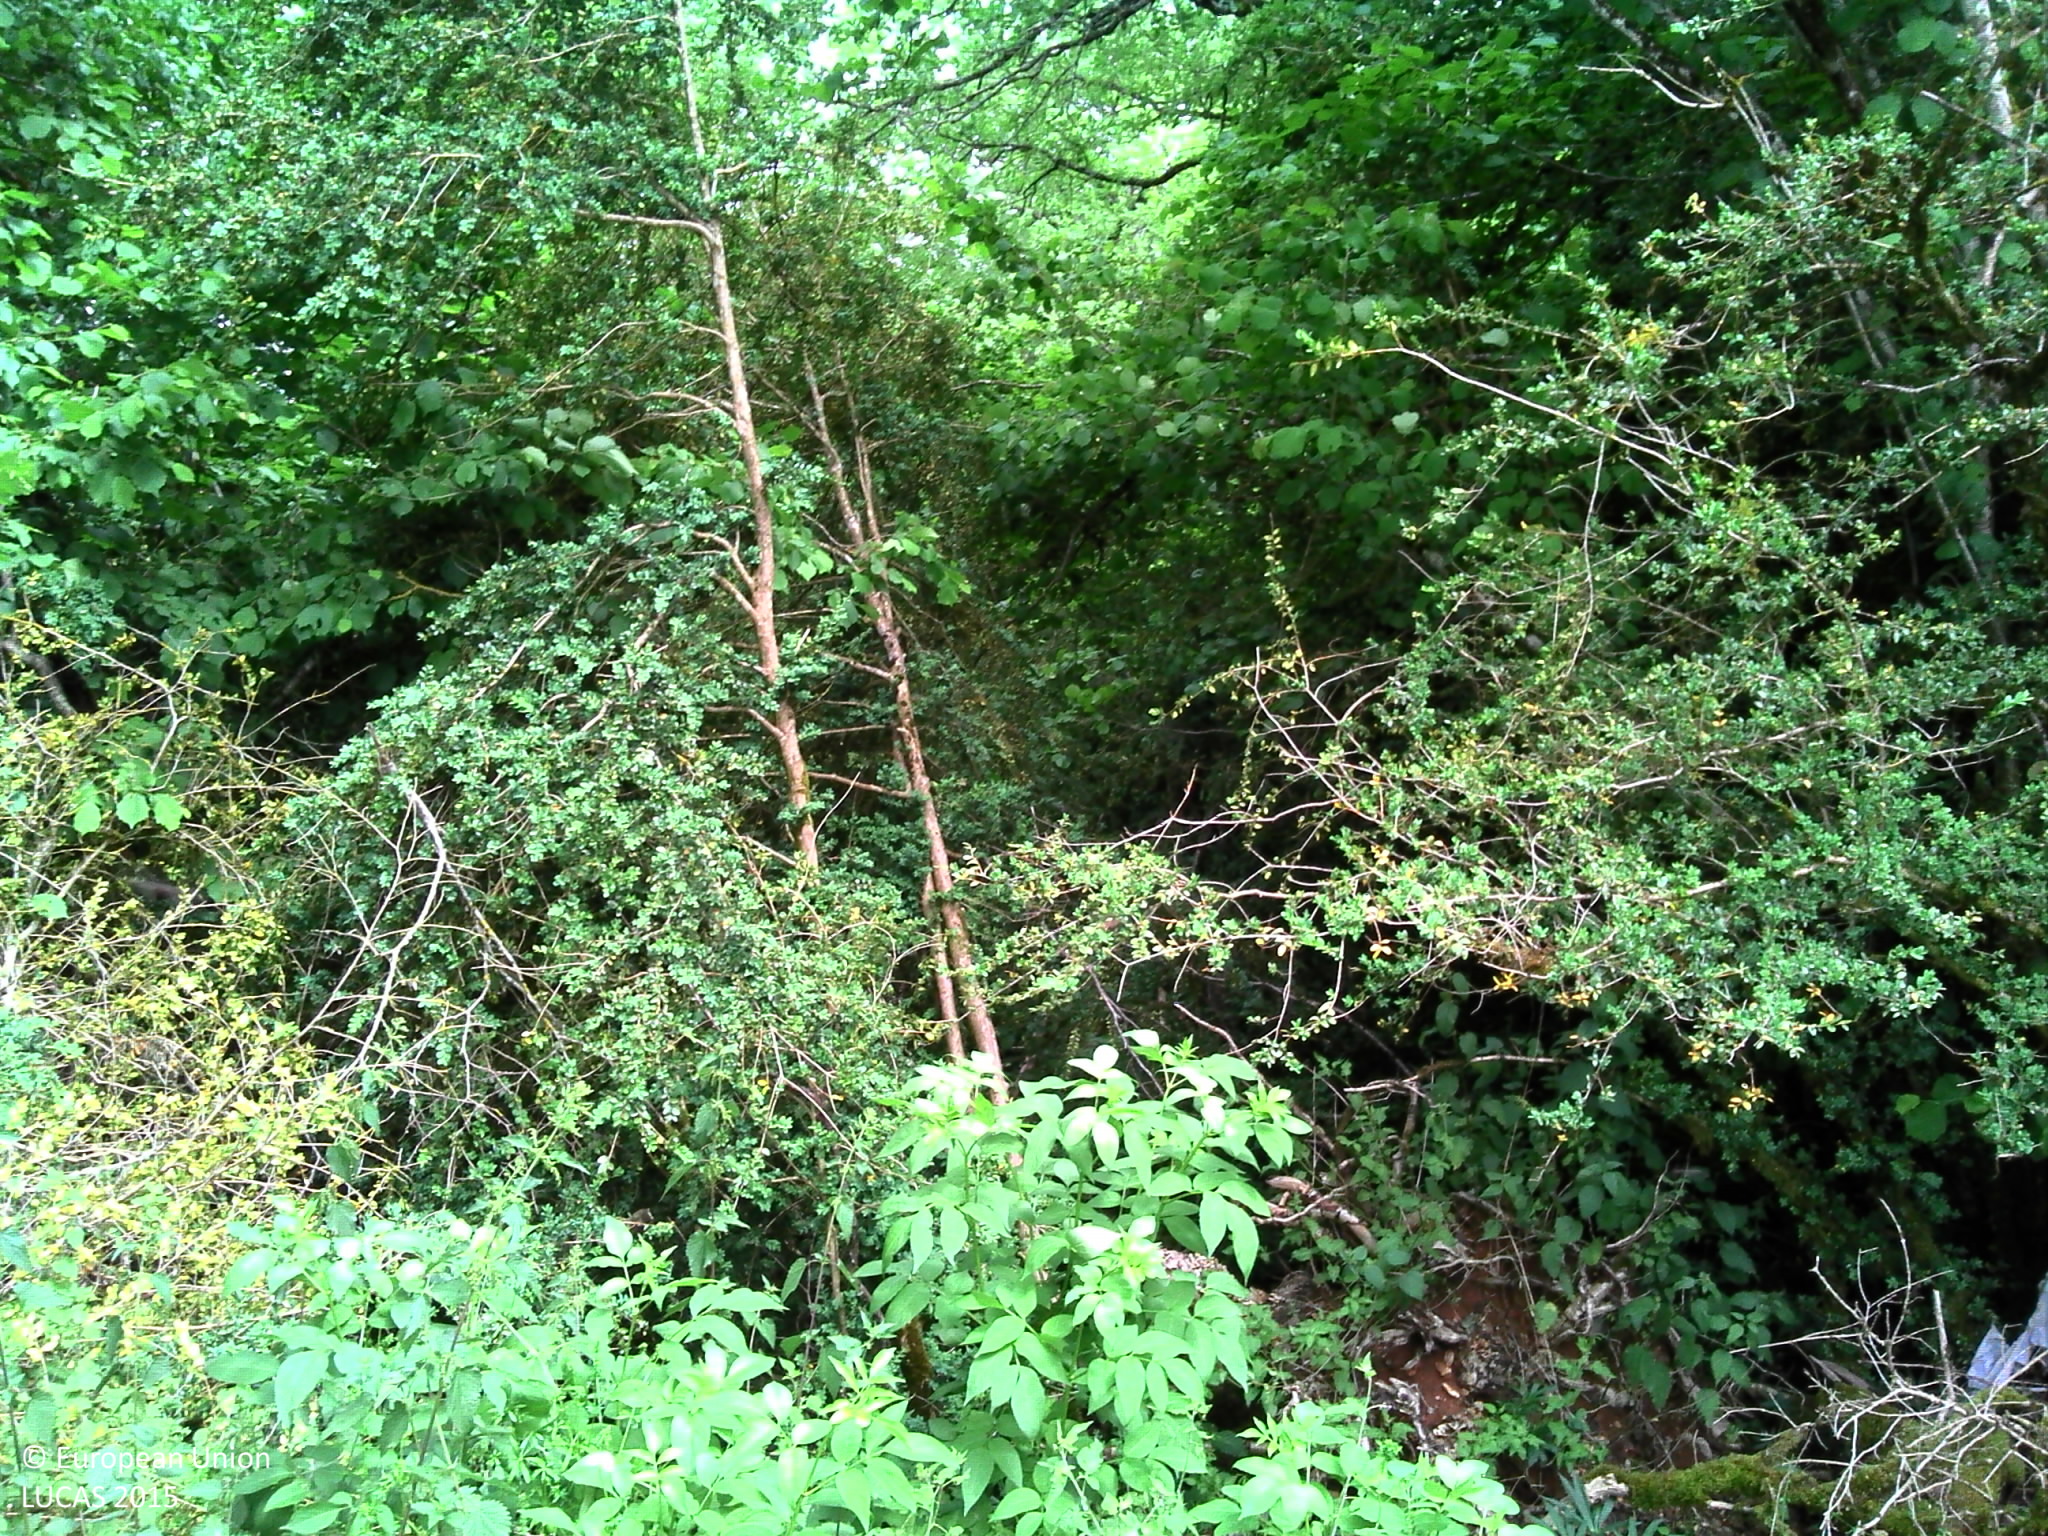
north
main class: Woodland
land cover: Broadleaved woodland
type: acidophilous oak and oak-birch forest
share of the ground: > 75 %
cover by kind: broadleaved forest trees 90 %, lichens and mosses 10 %
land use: Semi-natural and natural areas not in use
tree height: > 5 m
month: June
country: FR
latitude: 44.2820
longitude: 3.0758
